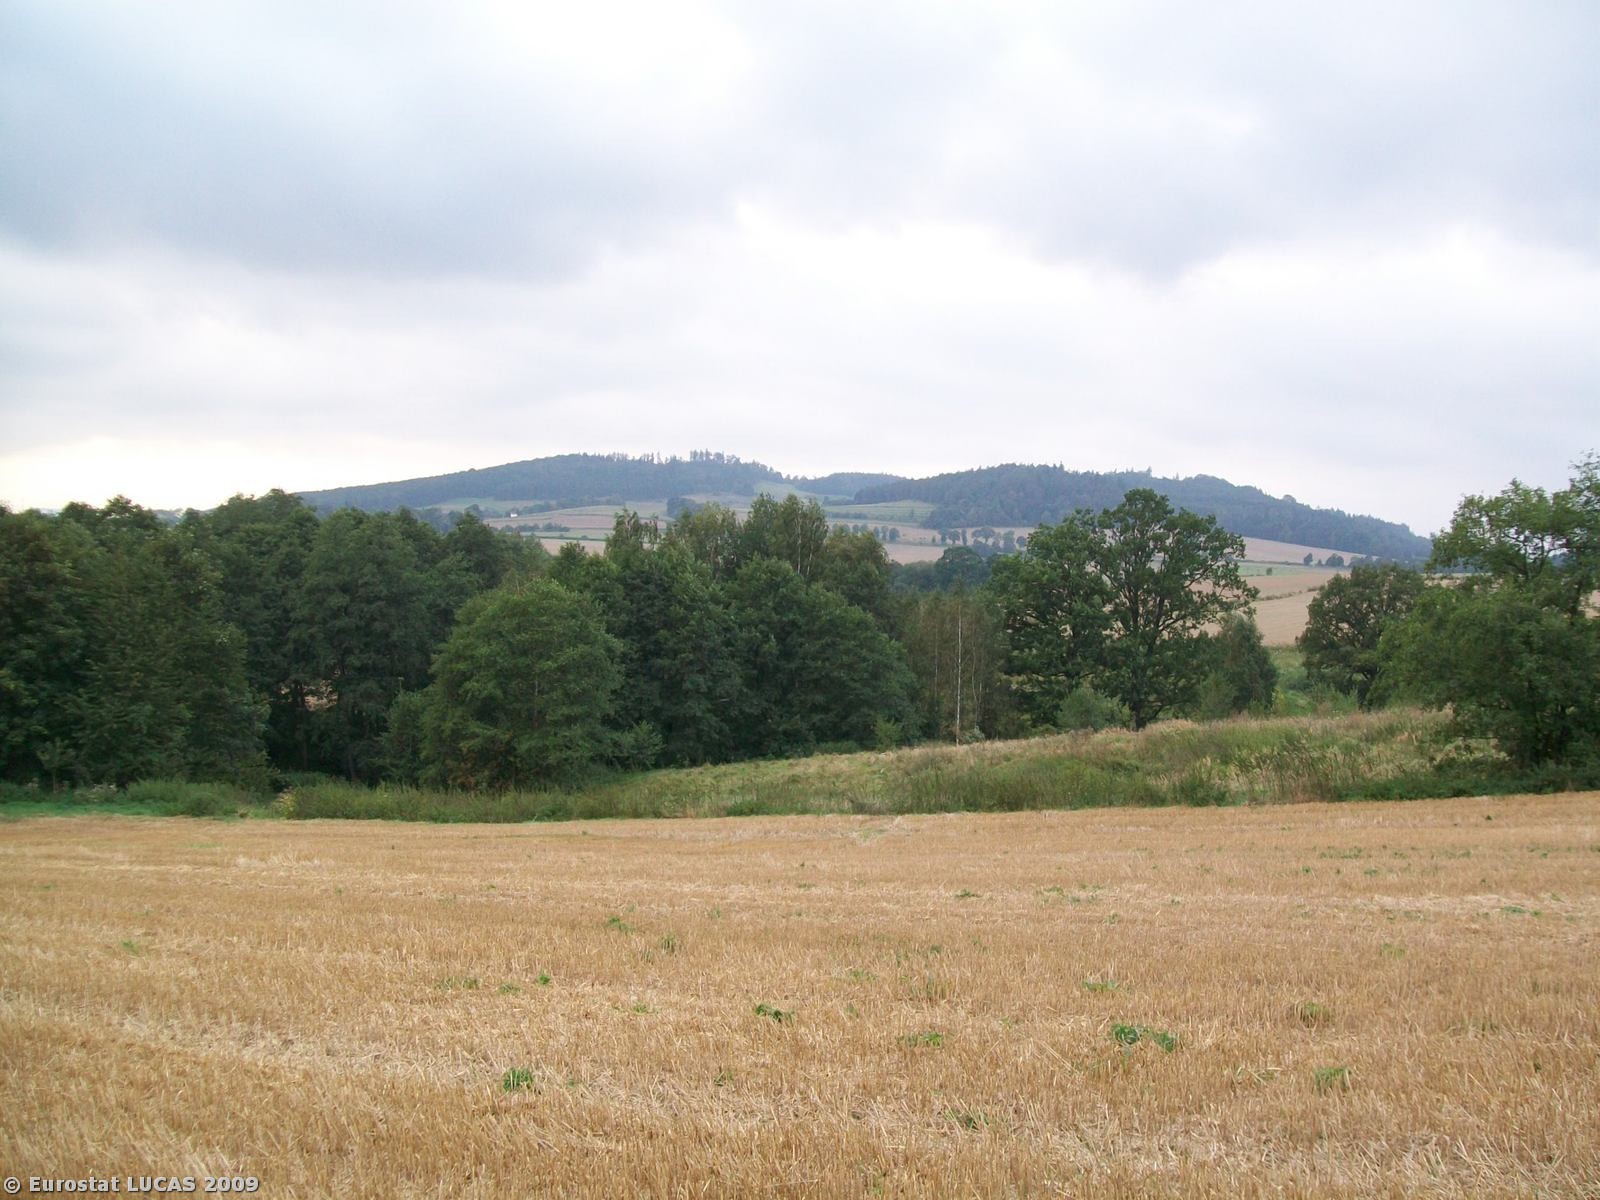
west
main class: Cropland
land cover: Common wheat
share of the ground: < 10 %
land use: Agriculture (excluding fallow land and kitchen gardens)
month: September
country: PL
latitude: 50.4954
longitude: 16.6480
